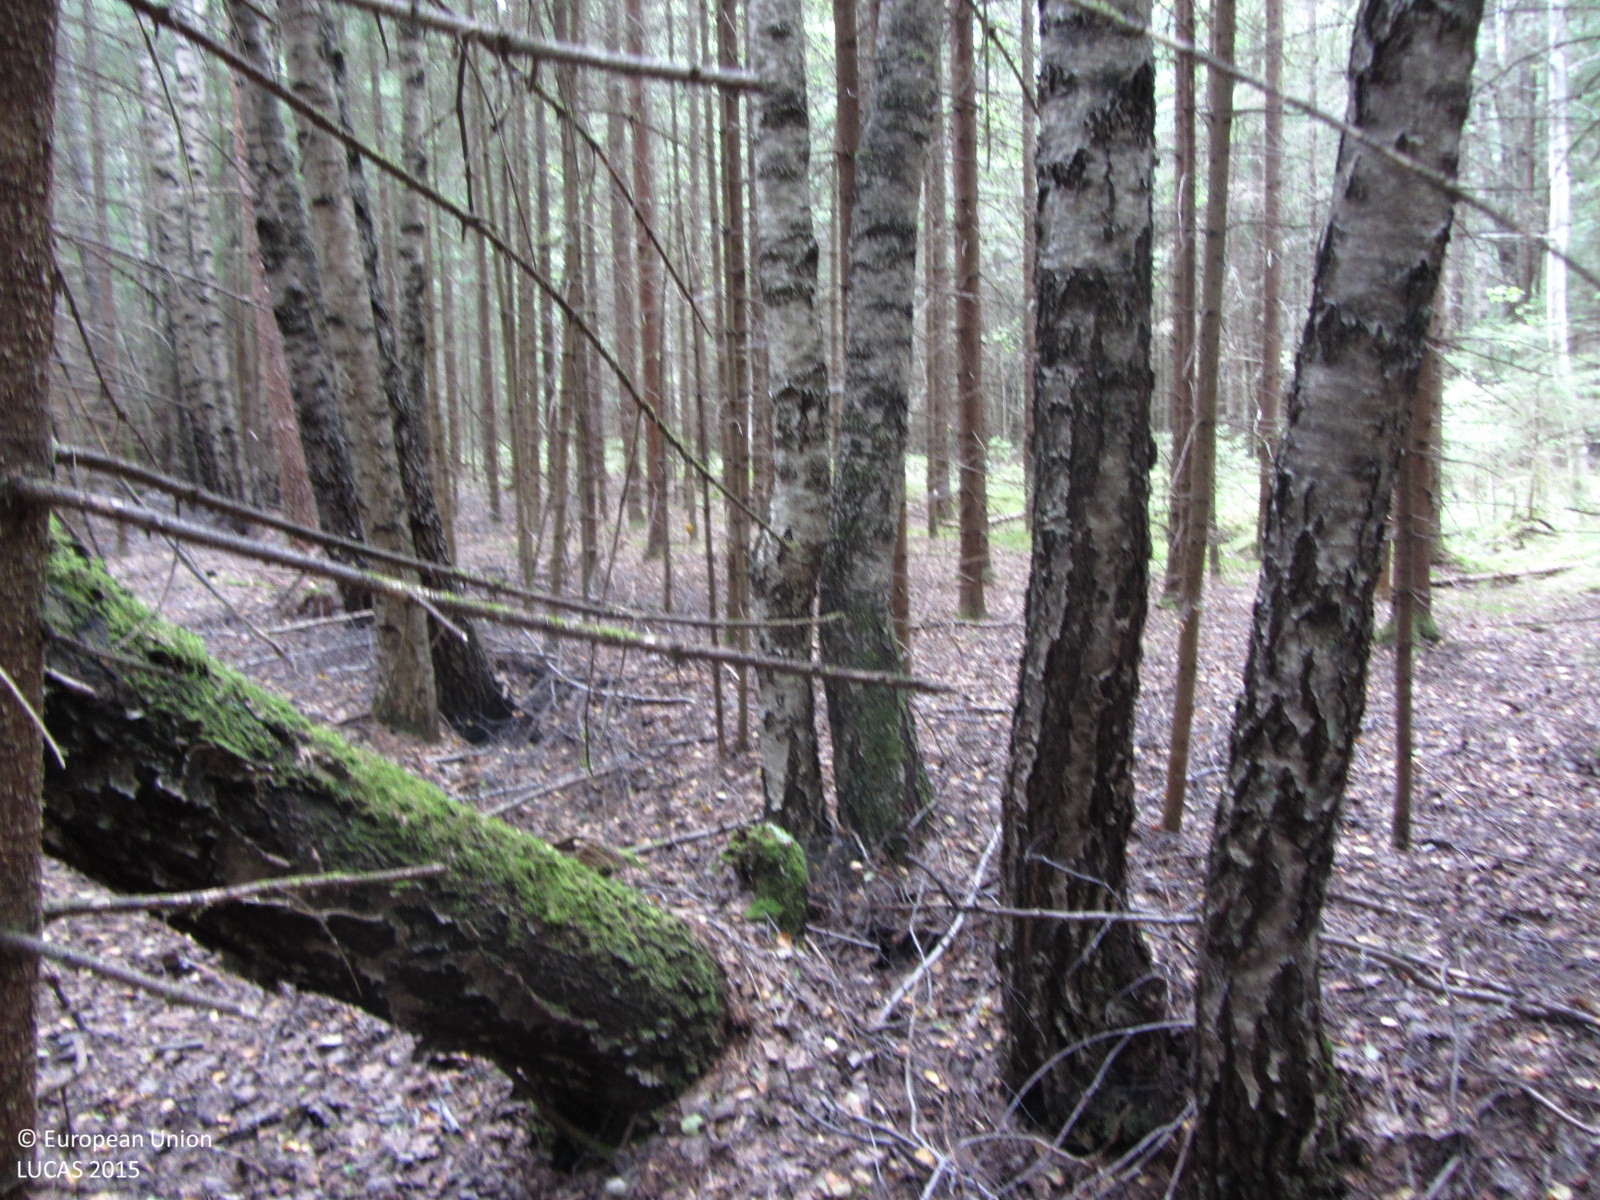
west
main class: Woodland
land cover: Spruce dominated mixed woodland
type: boreal forest
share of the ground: > 75 %
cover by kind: coniferous forest trees 70 %, broadleaved forest trees 30 %
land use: Forestry
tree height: > 5 m
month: August
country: FI
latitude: 60.2835
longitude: 23.8207
